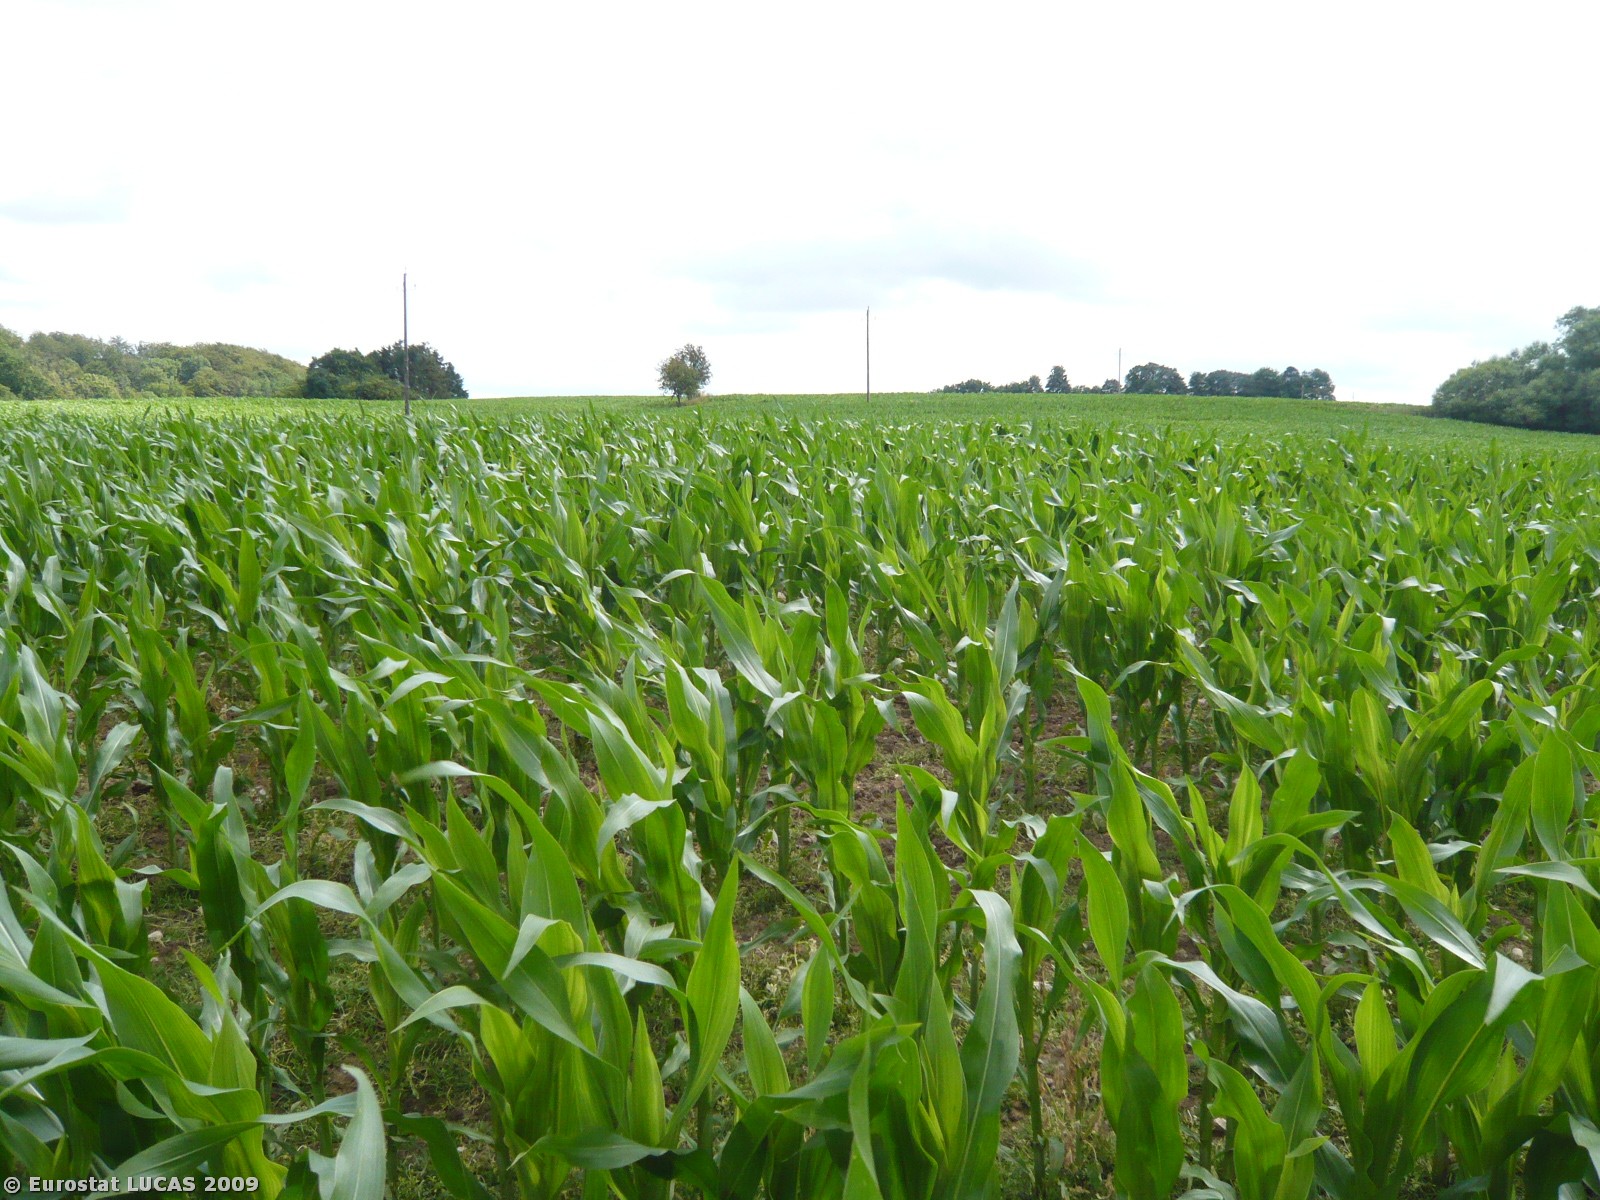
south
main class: Cropland
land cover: Maize
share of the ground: > 75 %
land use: Agriculture (excluding fallow land and kitchen gardens)
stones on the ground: < 10 %
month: July
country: DK
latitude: 55.5267
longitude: 11.8835
